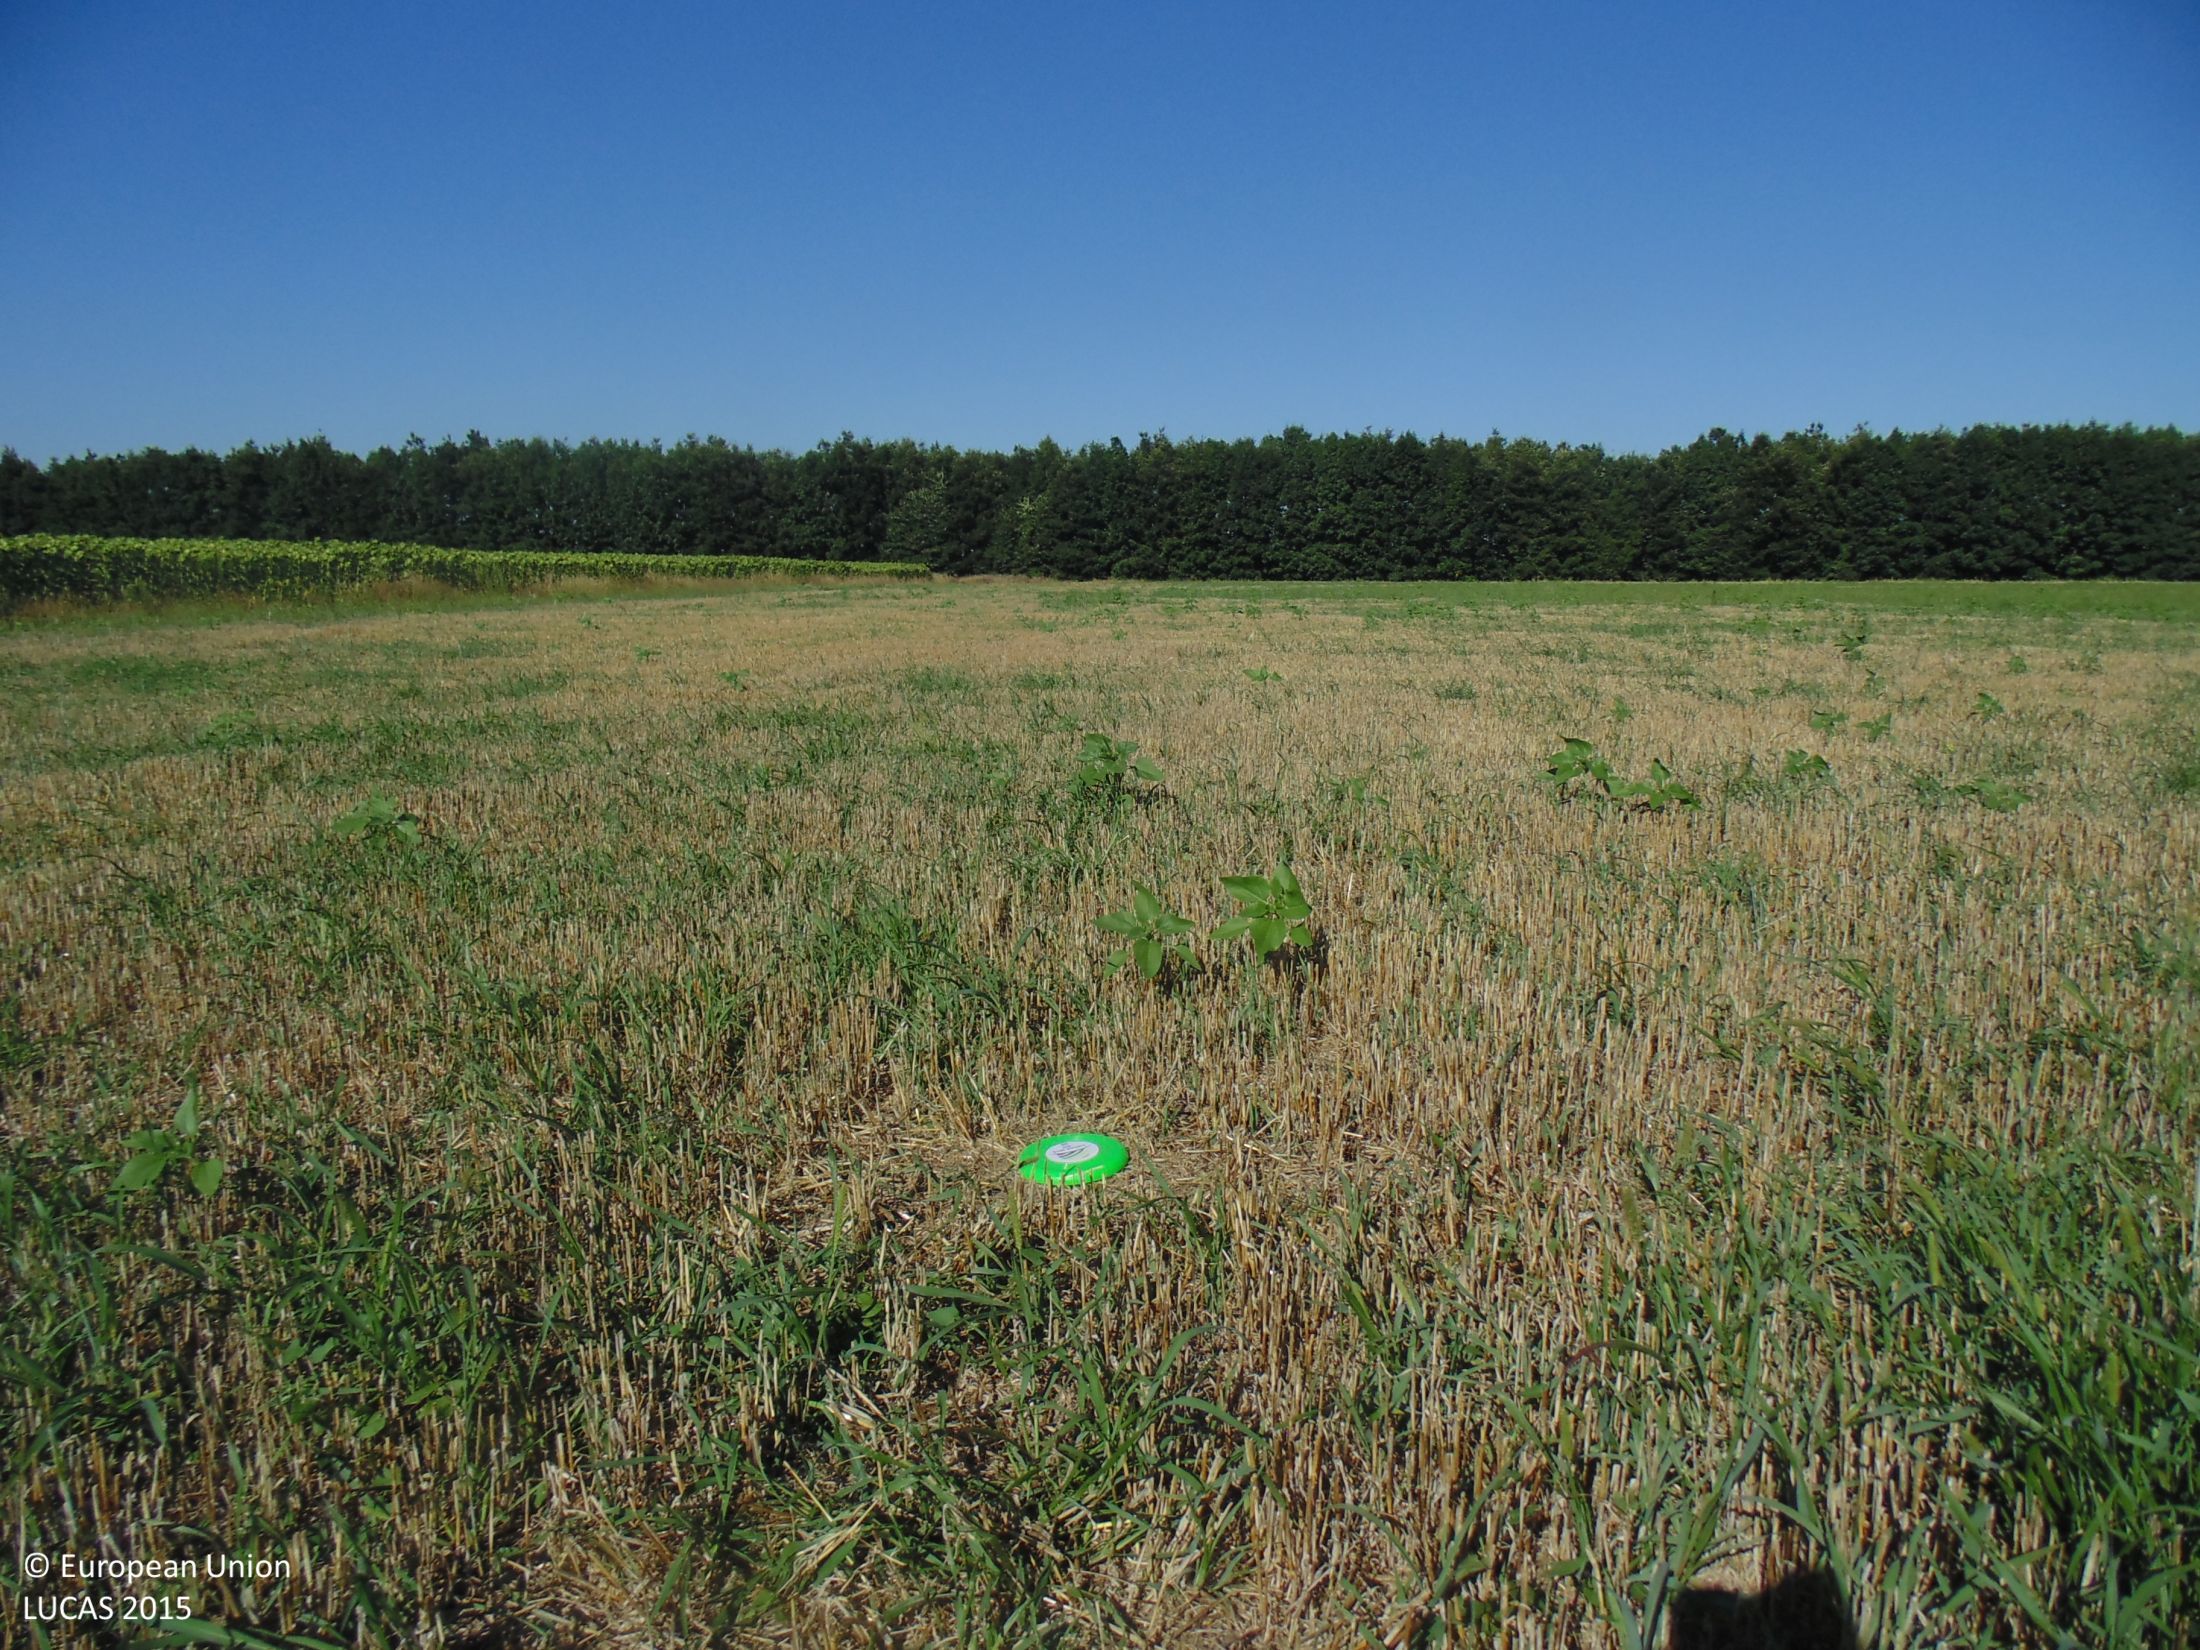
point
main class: Cropland
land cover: Barley
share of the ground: 10 - 25 %
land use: Agriculture (excluding fallow land and kitchen gardens)
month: July
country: BG
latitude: 43.4303
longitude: 28.0714
